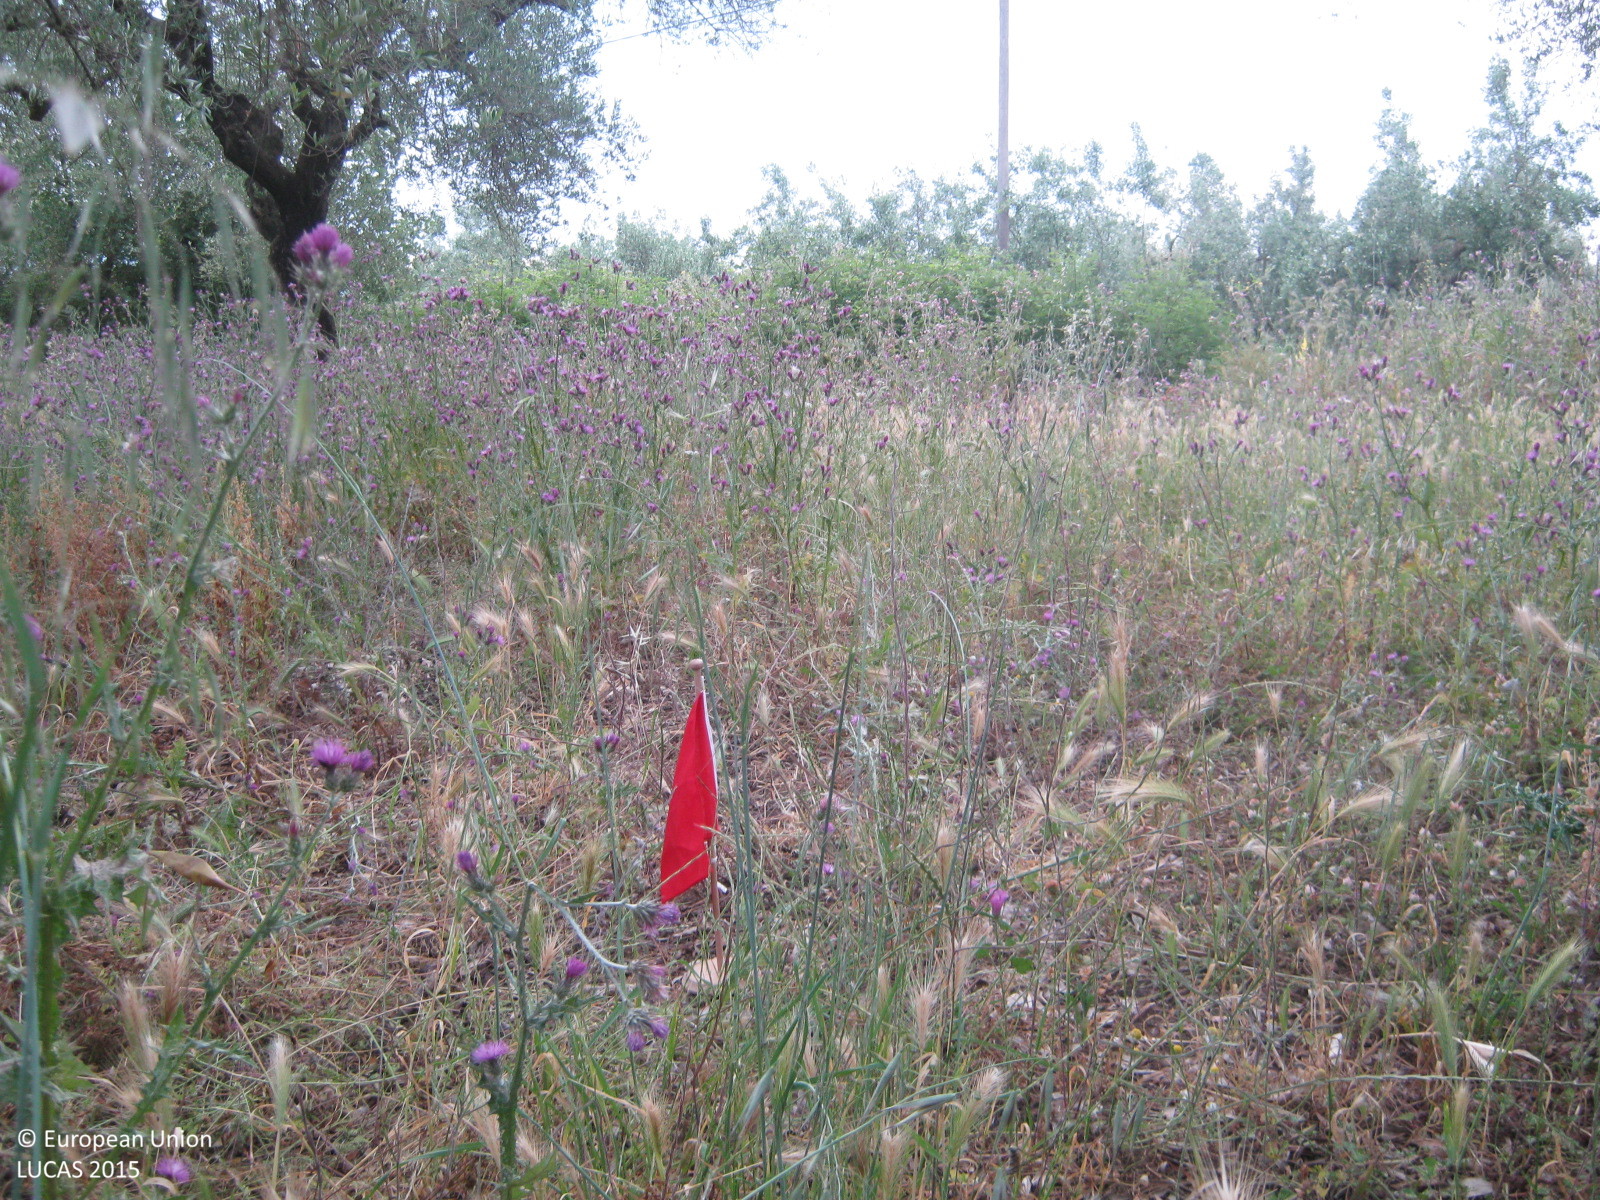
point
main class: Cropland
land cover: Olive groves
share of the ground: > 75 %
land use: Agriculture (excluding fallow land and kitchen gardens)
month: May
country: GR
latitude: 38.5456
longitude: 21.3621
